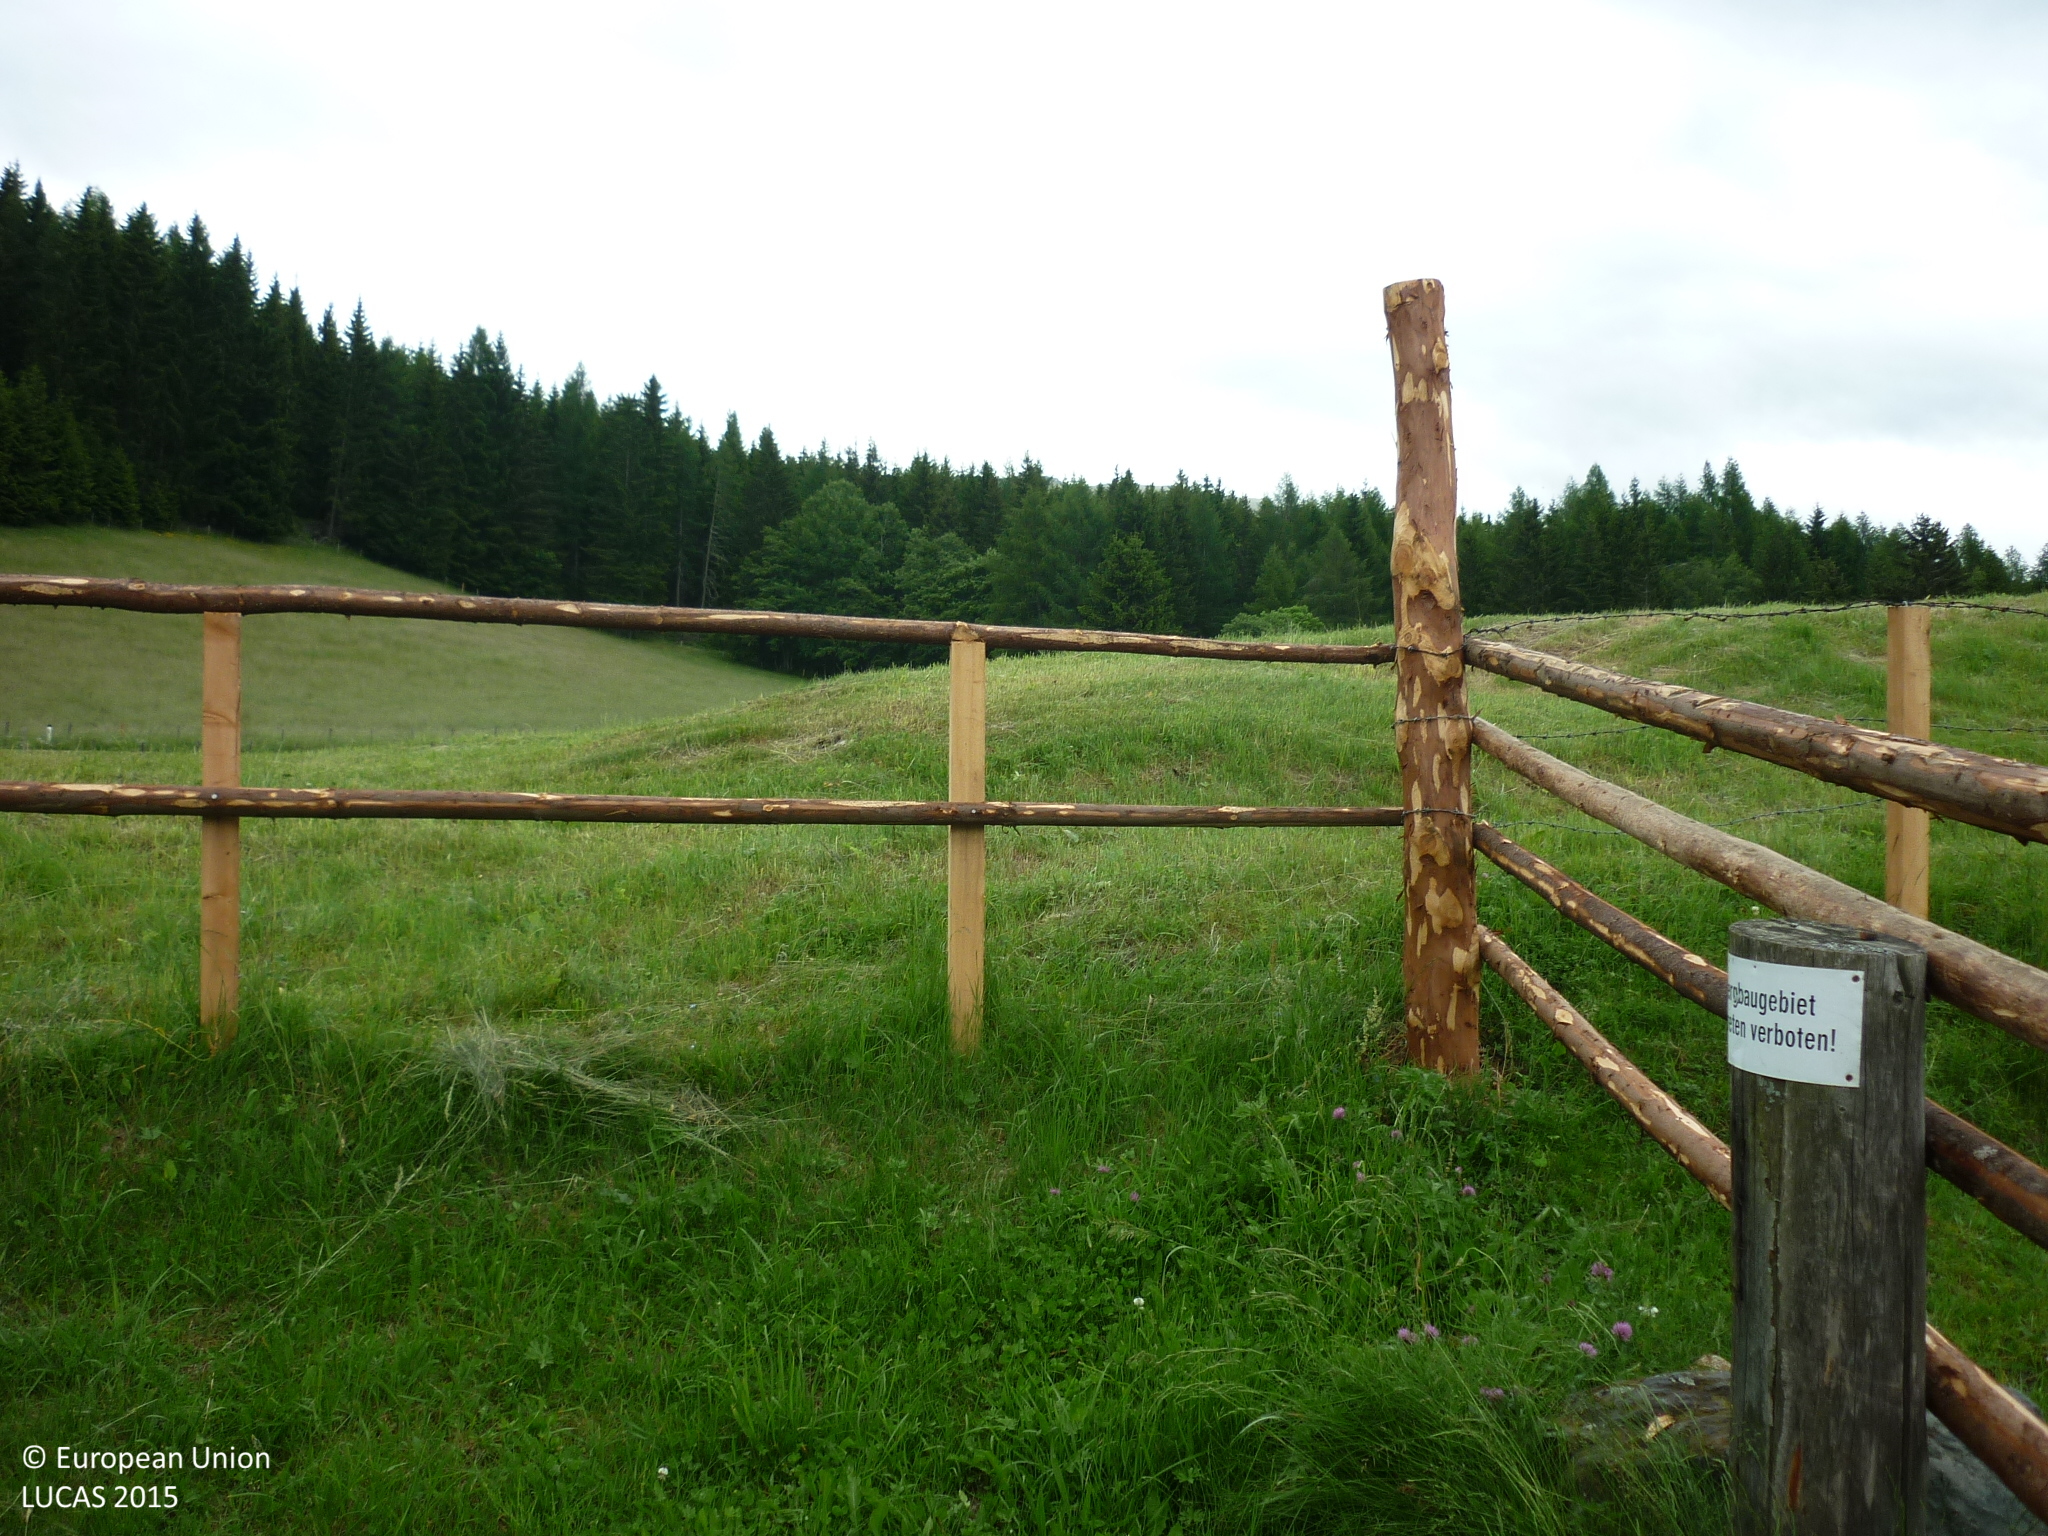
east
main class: Grassland
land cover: Grassland without tree/shrub cover
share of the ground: > 75 %
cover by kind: herbaceous plants 100 %
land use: Agriculture (excluding fallow land and kitchen gardens)
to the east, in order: Tracks; Grassland without tree/shrub cover; Fences; Grassland without tree/shrub cover; Single bushes/trees; Fences; Grass margins; Paved roads, cycling and walking lanes; Grass margins; Single bushes/trees; Fences; Grassland without tree/shrub cover; Other mixed woodland; Fences; Other mixed woodland; Spruce dominated coniferous woodland; Paved roads, cycling and walking lanes; Spruce dominated coniferous woodland; Ditches and canals; Spruce dominated coniferous woodland
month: June
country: AT
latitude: 47.0866
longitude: 14.4902
